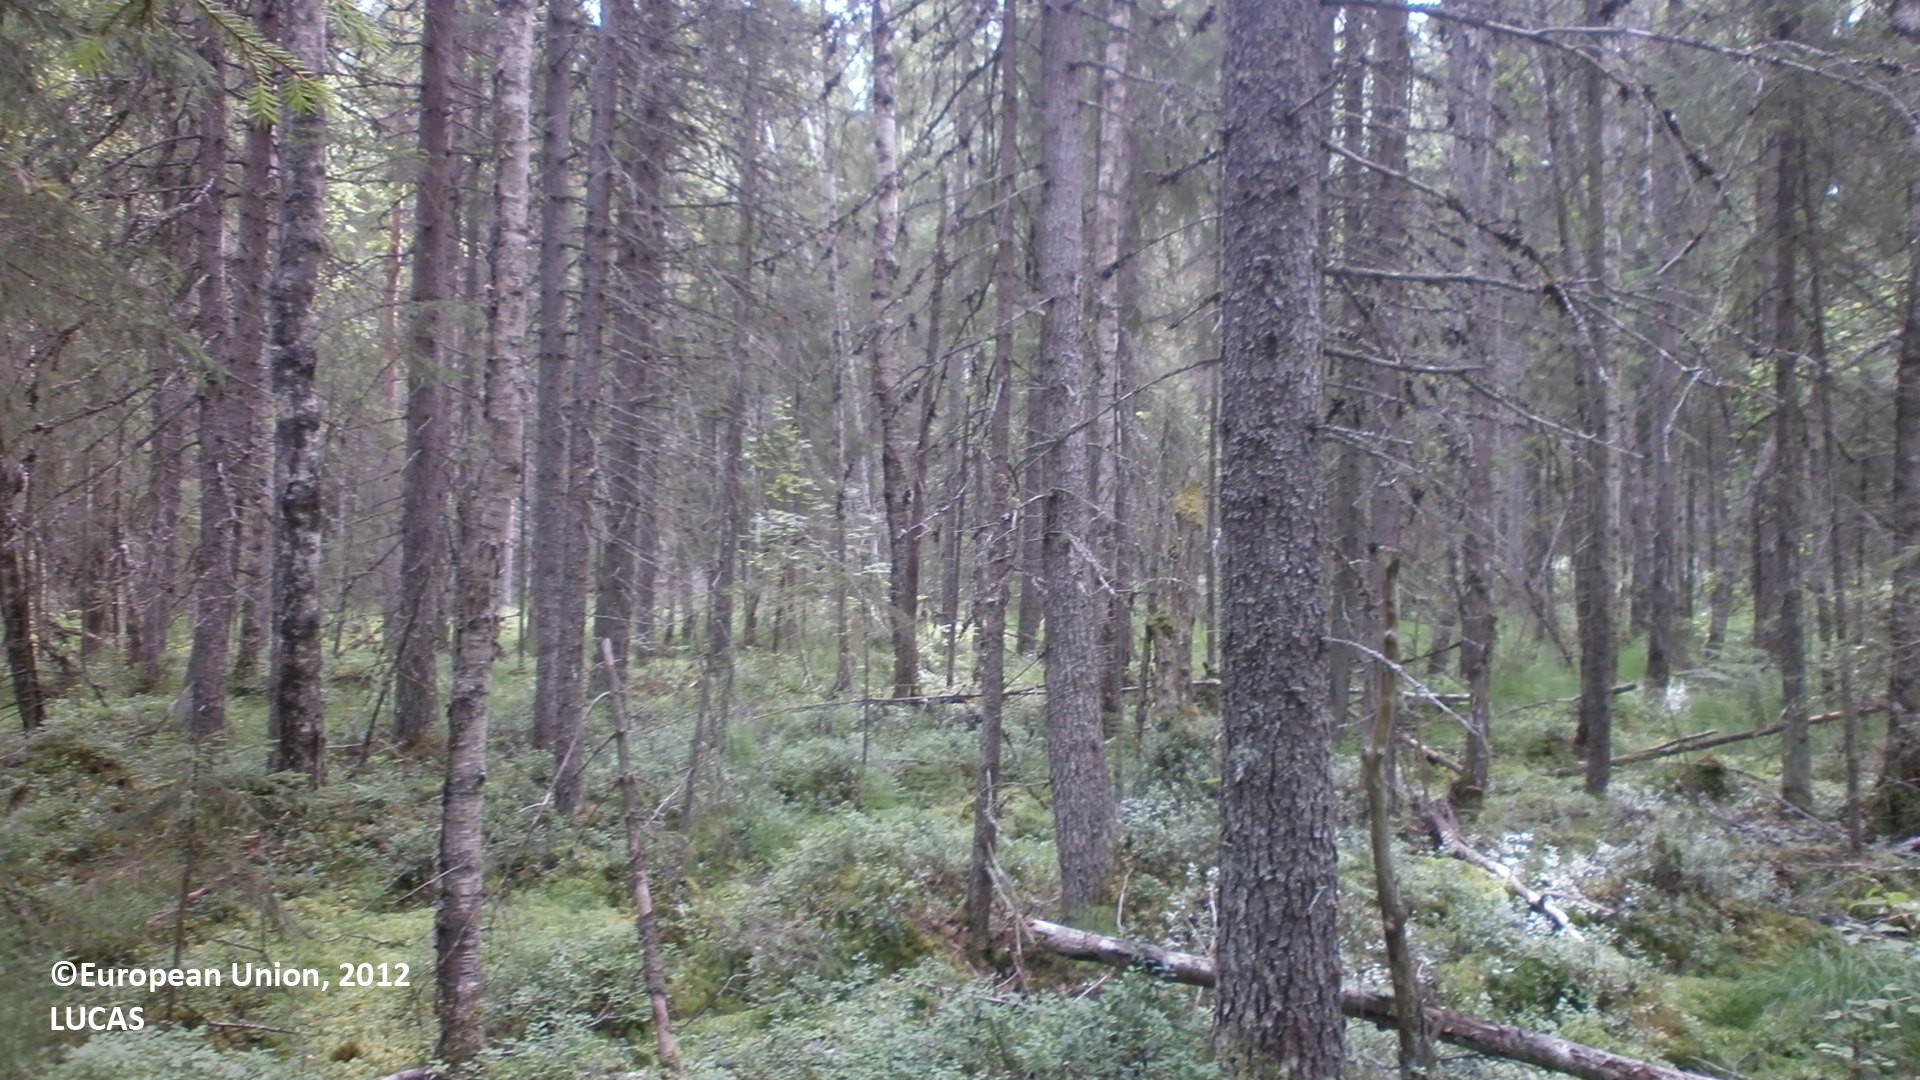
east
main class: Woodland
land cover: Spruce dominated mixed woodland
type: boreal forest
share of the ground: > 75 %
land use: Forestry
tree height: > 5 m
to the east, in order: Spruce dominated mixed woodland; Tracks; Spruce dominated coniferous woodland; Spruce dominated mixed woodland; Pine dominated mixed woodland; Spruce dominated mixed woodland
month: July
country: FI
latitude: 64.0768
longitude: 23.9018
